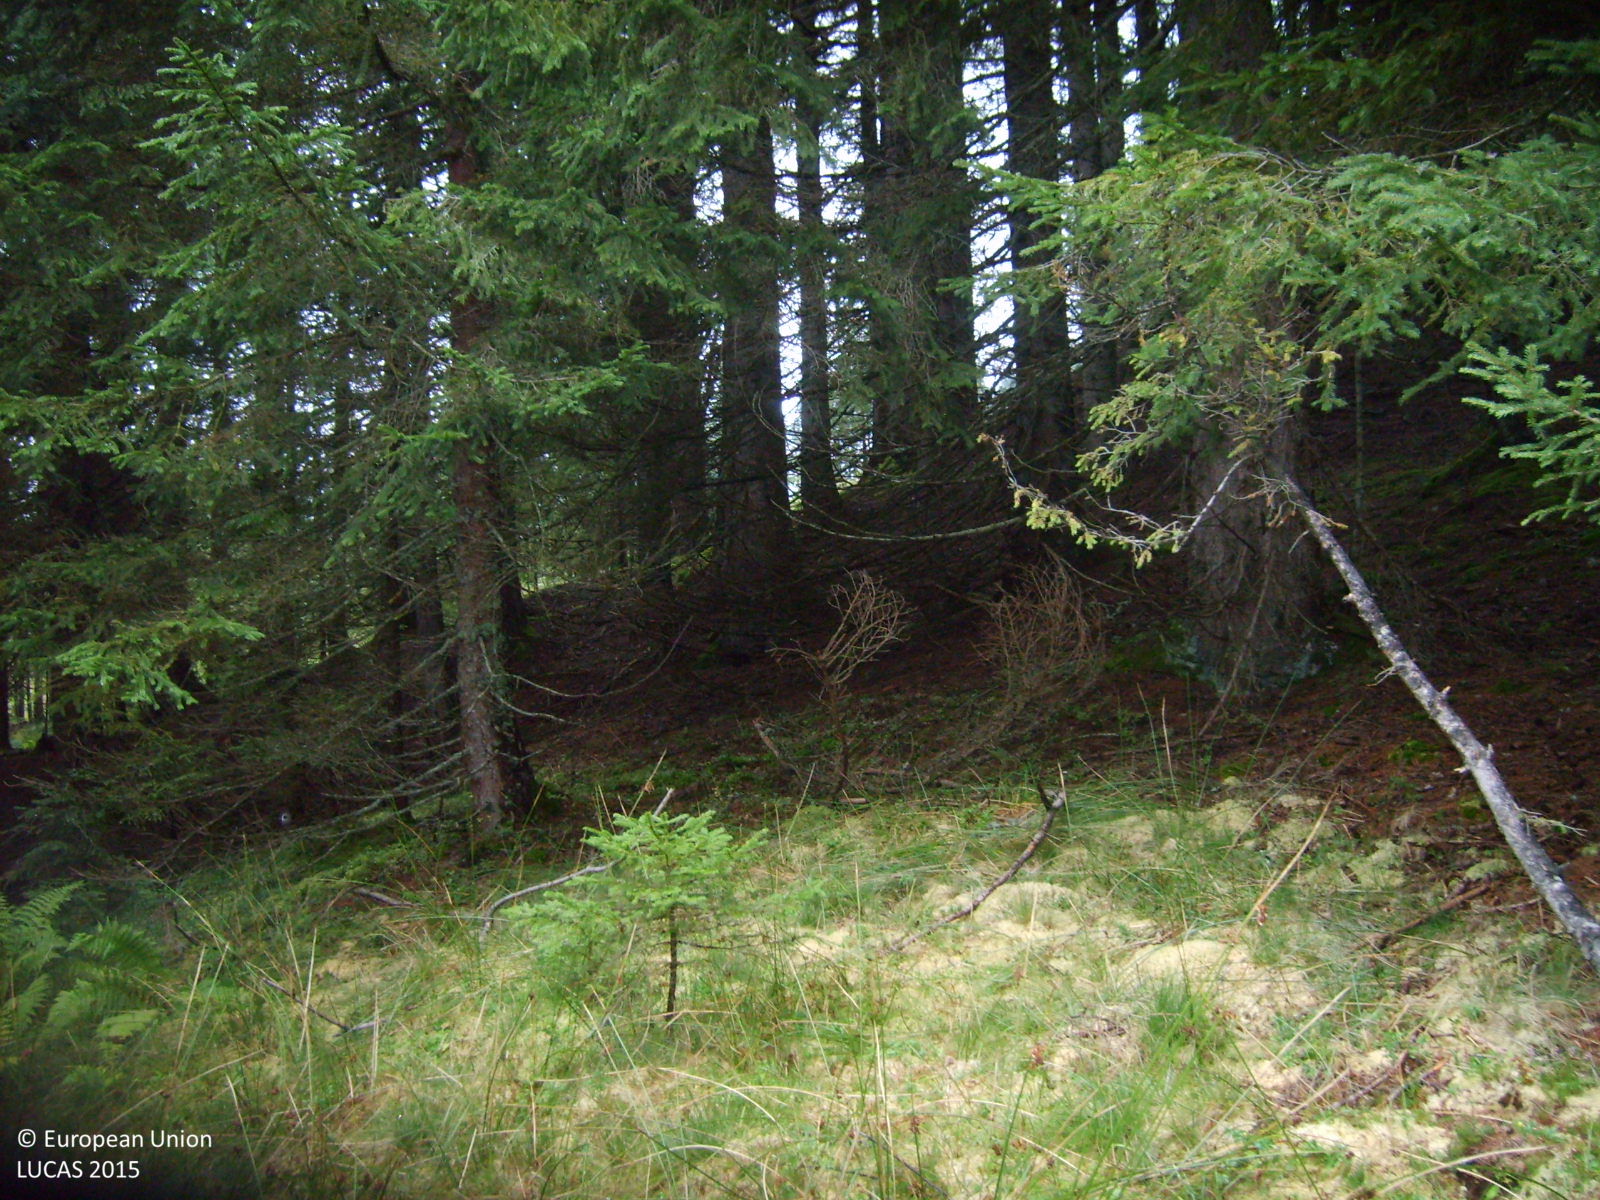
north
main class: Woodland
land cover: Spruce dominated coniferous woodland
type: alpine coniferous forest
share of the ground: > 75 %
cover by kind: coniferous forest trees 70 %, broadleaved forest trees 10 %, shrubs 10 %, herbaceous plants 10 %
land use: Forestry
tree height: > 5 m
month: September
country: AT
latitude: 47.4847
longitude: 13.4622
